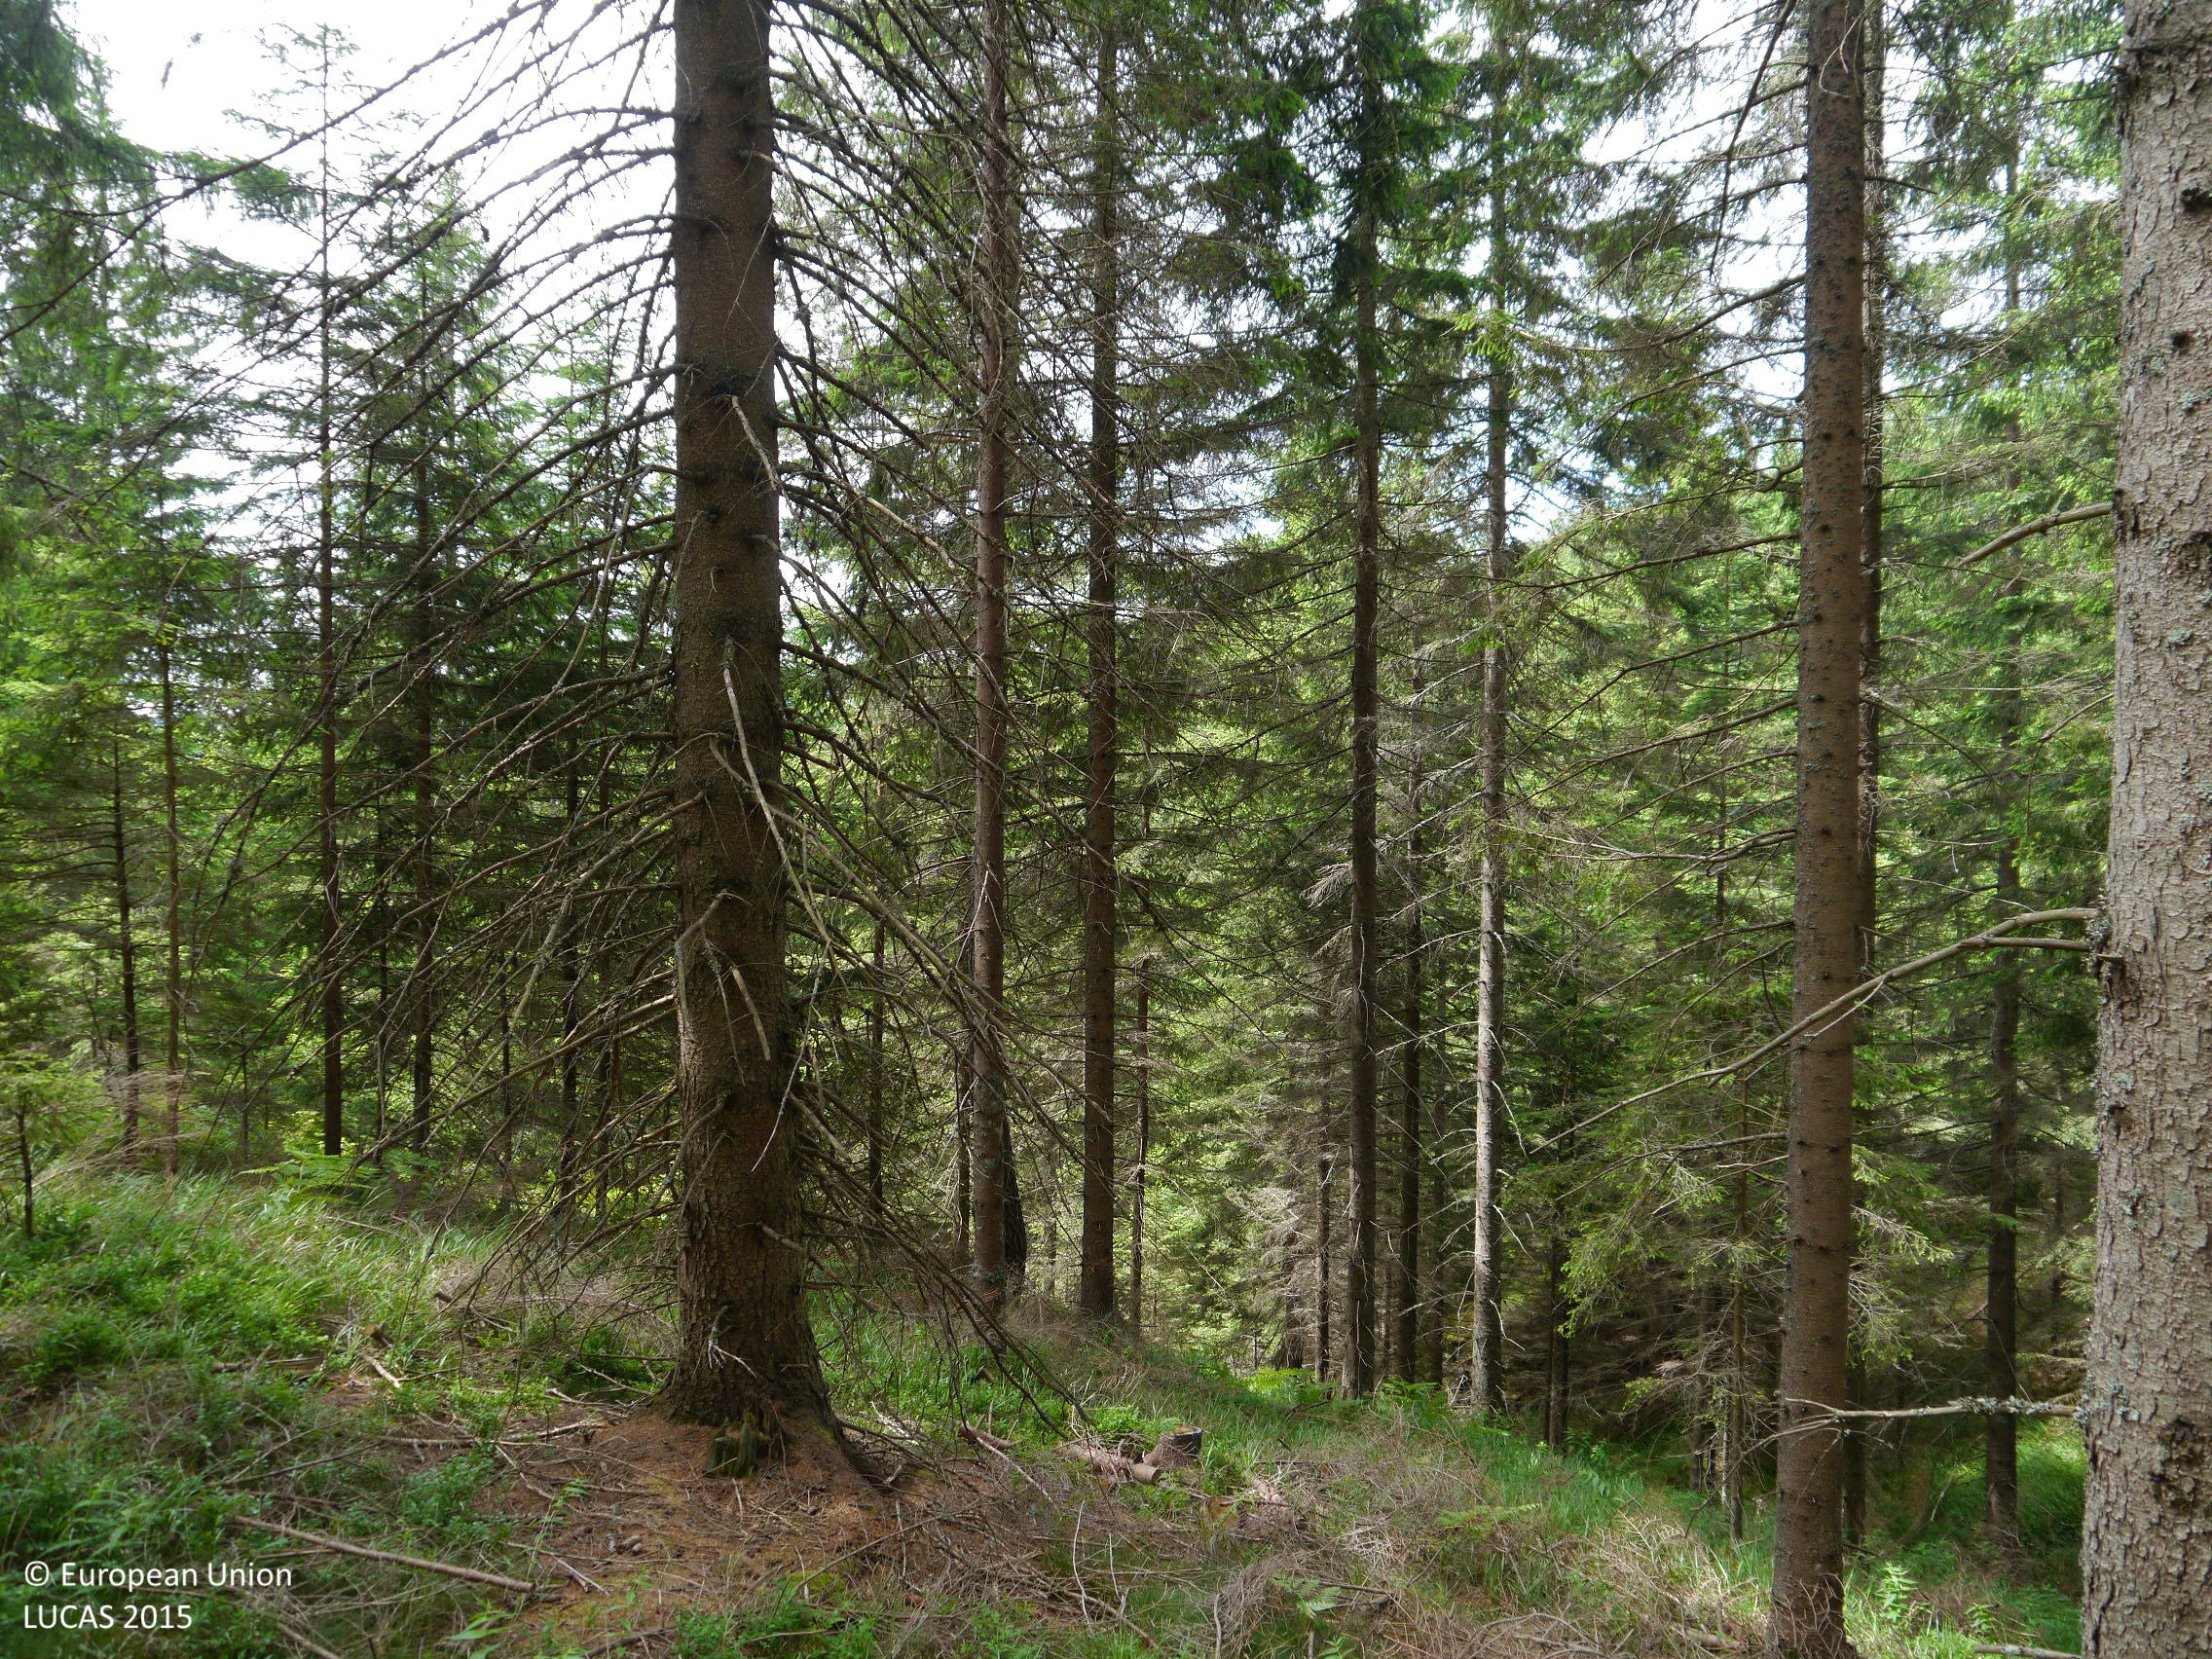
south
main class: Woodland
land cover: Spruce dominated coniferous woodland
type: alpine coniferous forest
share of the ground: > 75 %
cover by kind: coniferous forest trees 70 %, shrubs 20 %, herbaceous plants 10 %
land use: Forestry
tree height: > 5 m
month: June
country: AT
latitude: 46.7353
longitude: 15.0893
